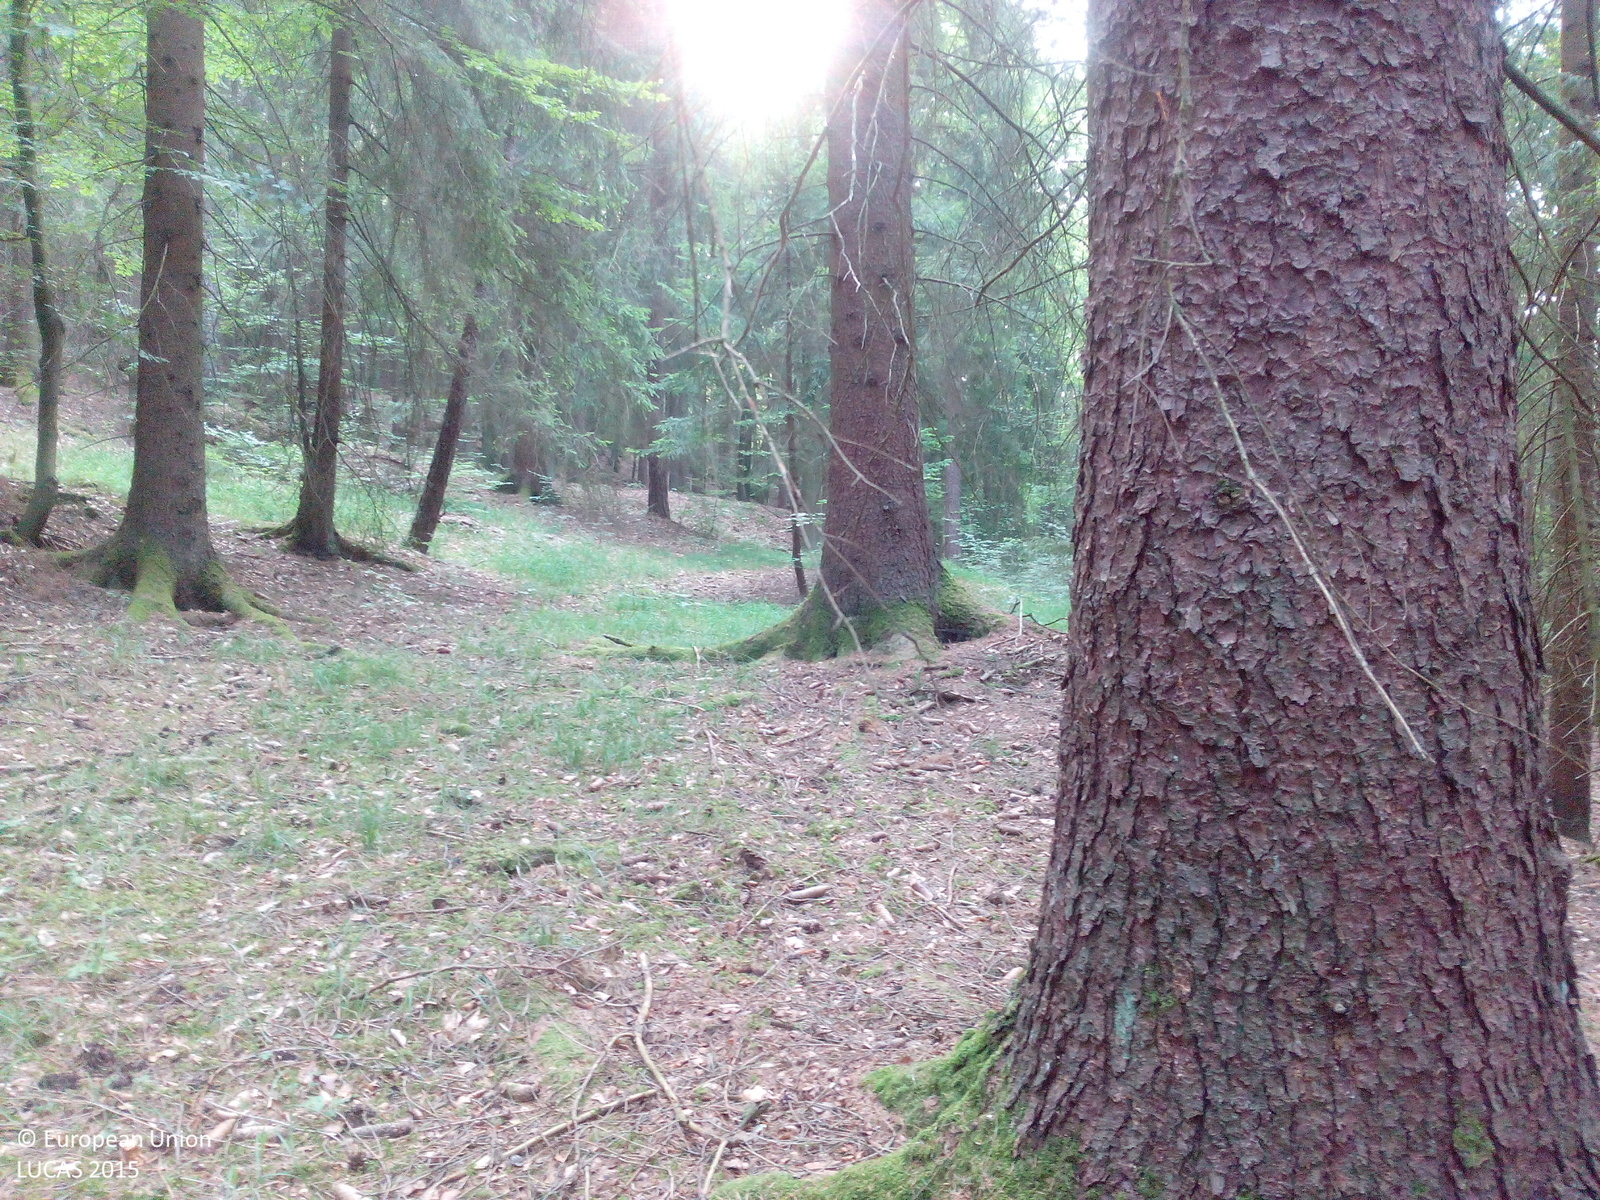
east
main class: Woodland
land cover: Other mixed woodland
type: hemiboreal forest and nemoral coniferous forest and mixed broadleaved-coniferous forest
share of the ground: > 75 %
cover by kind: coniferous forest trees 60 %, broadleaved forest trees 25 %, lichens and mosses 10 %
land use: Forestry
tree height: > 5 m
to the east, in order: Other mixed woodland; Tracks; Spruce dominated mixed woodland; Other mixed woodland; Broadleaved woodland; Tracks; Other mixed woodland
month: August
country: DE
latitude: 49.4725
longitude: 11.5313
